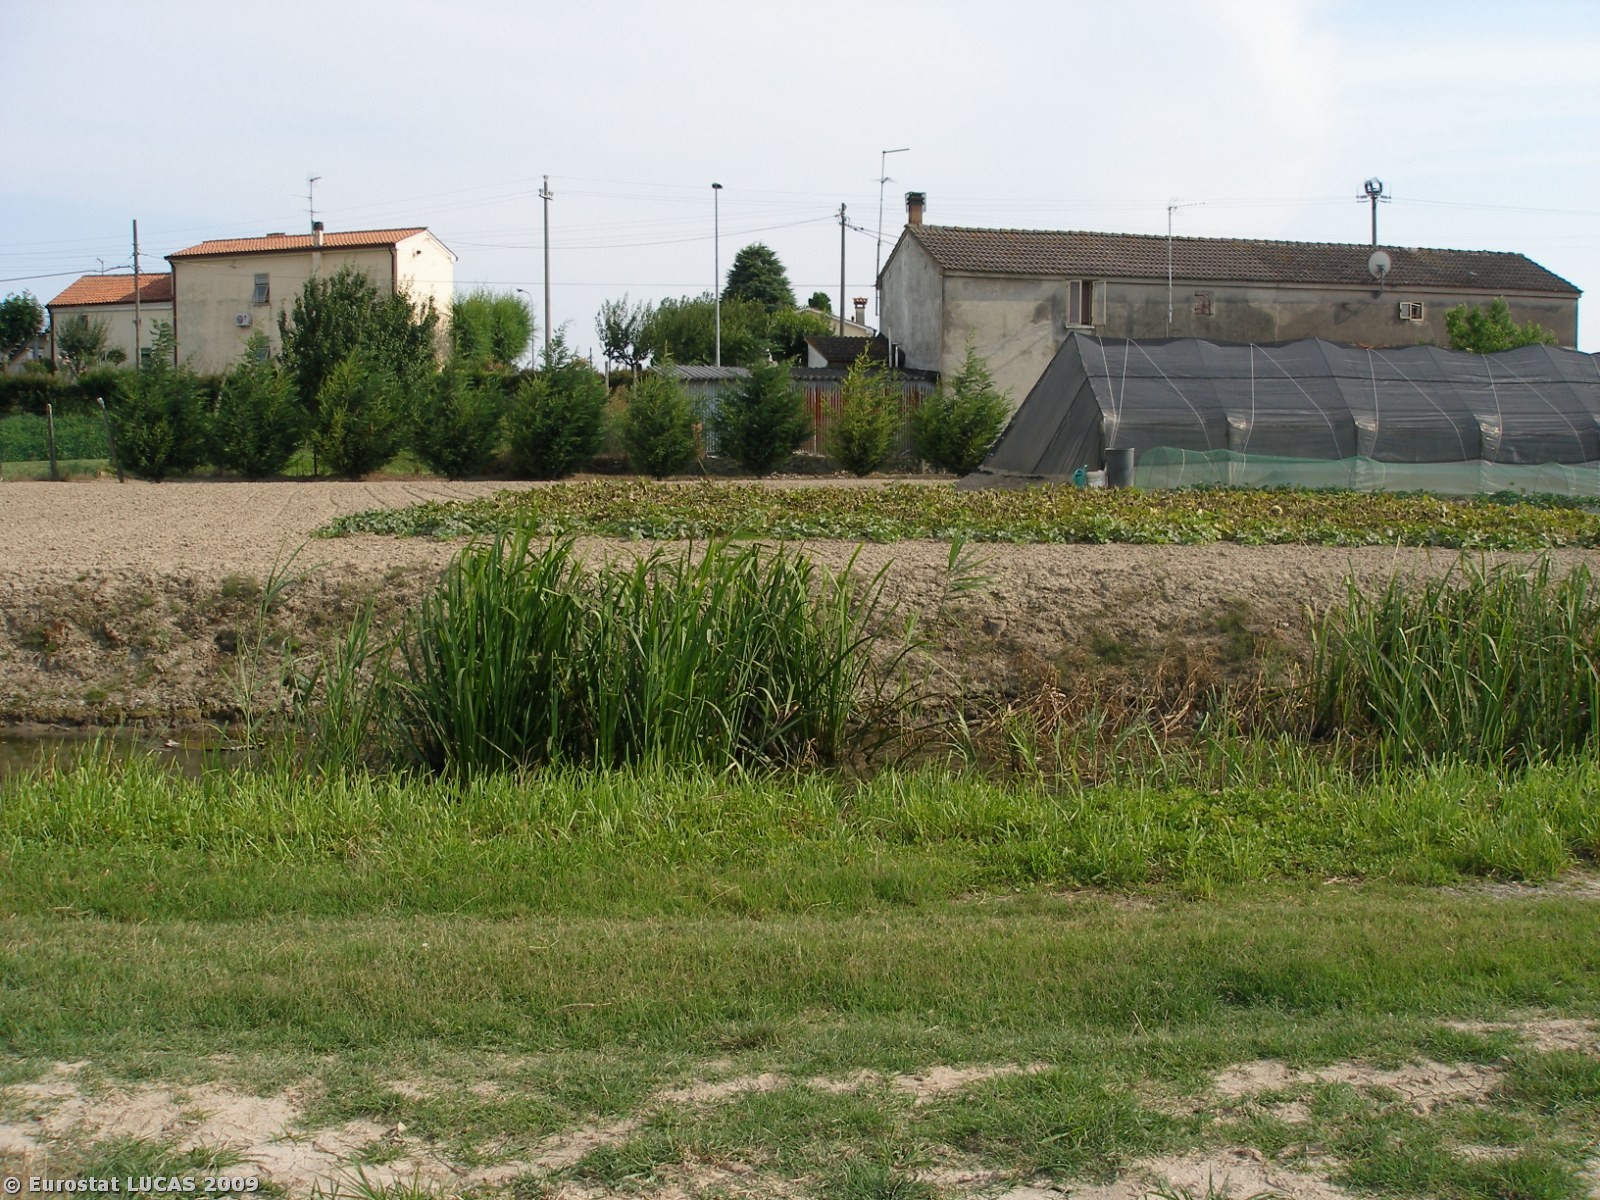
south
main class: Cropland
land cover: Tomatoes
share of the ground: > 75 %
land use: Agriculture (excluding fallow land and kitchen gardens)
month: July
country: IT
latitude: 45.0050
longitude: 11.6335
